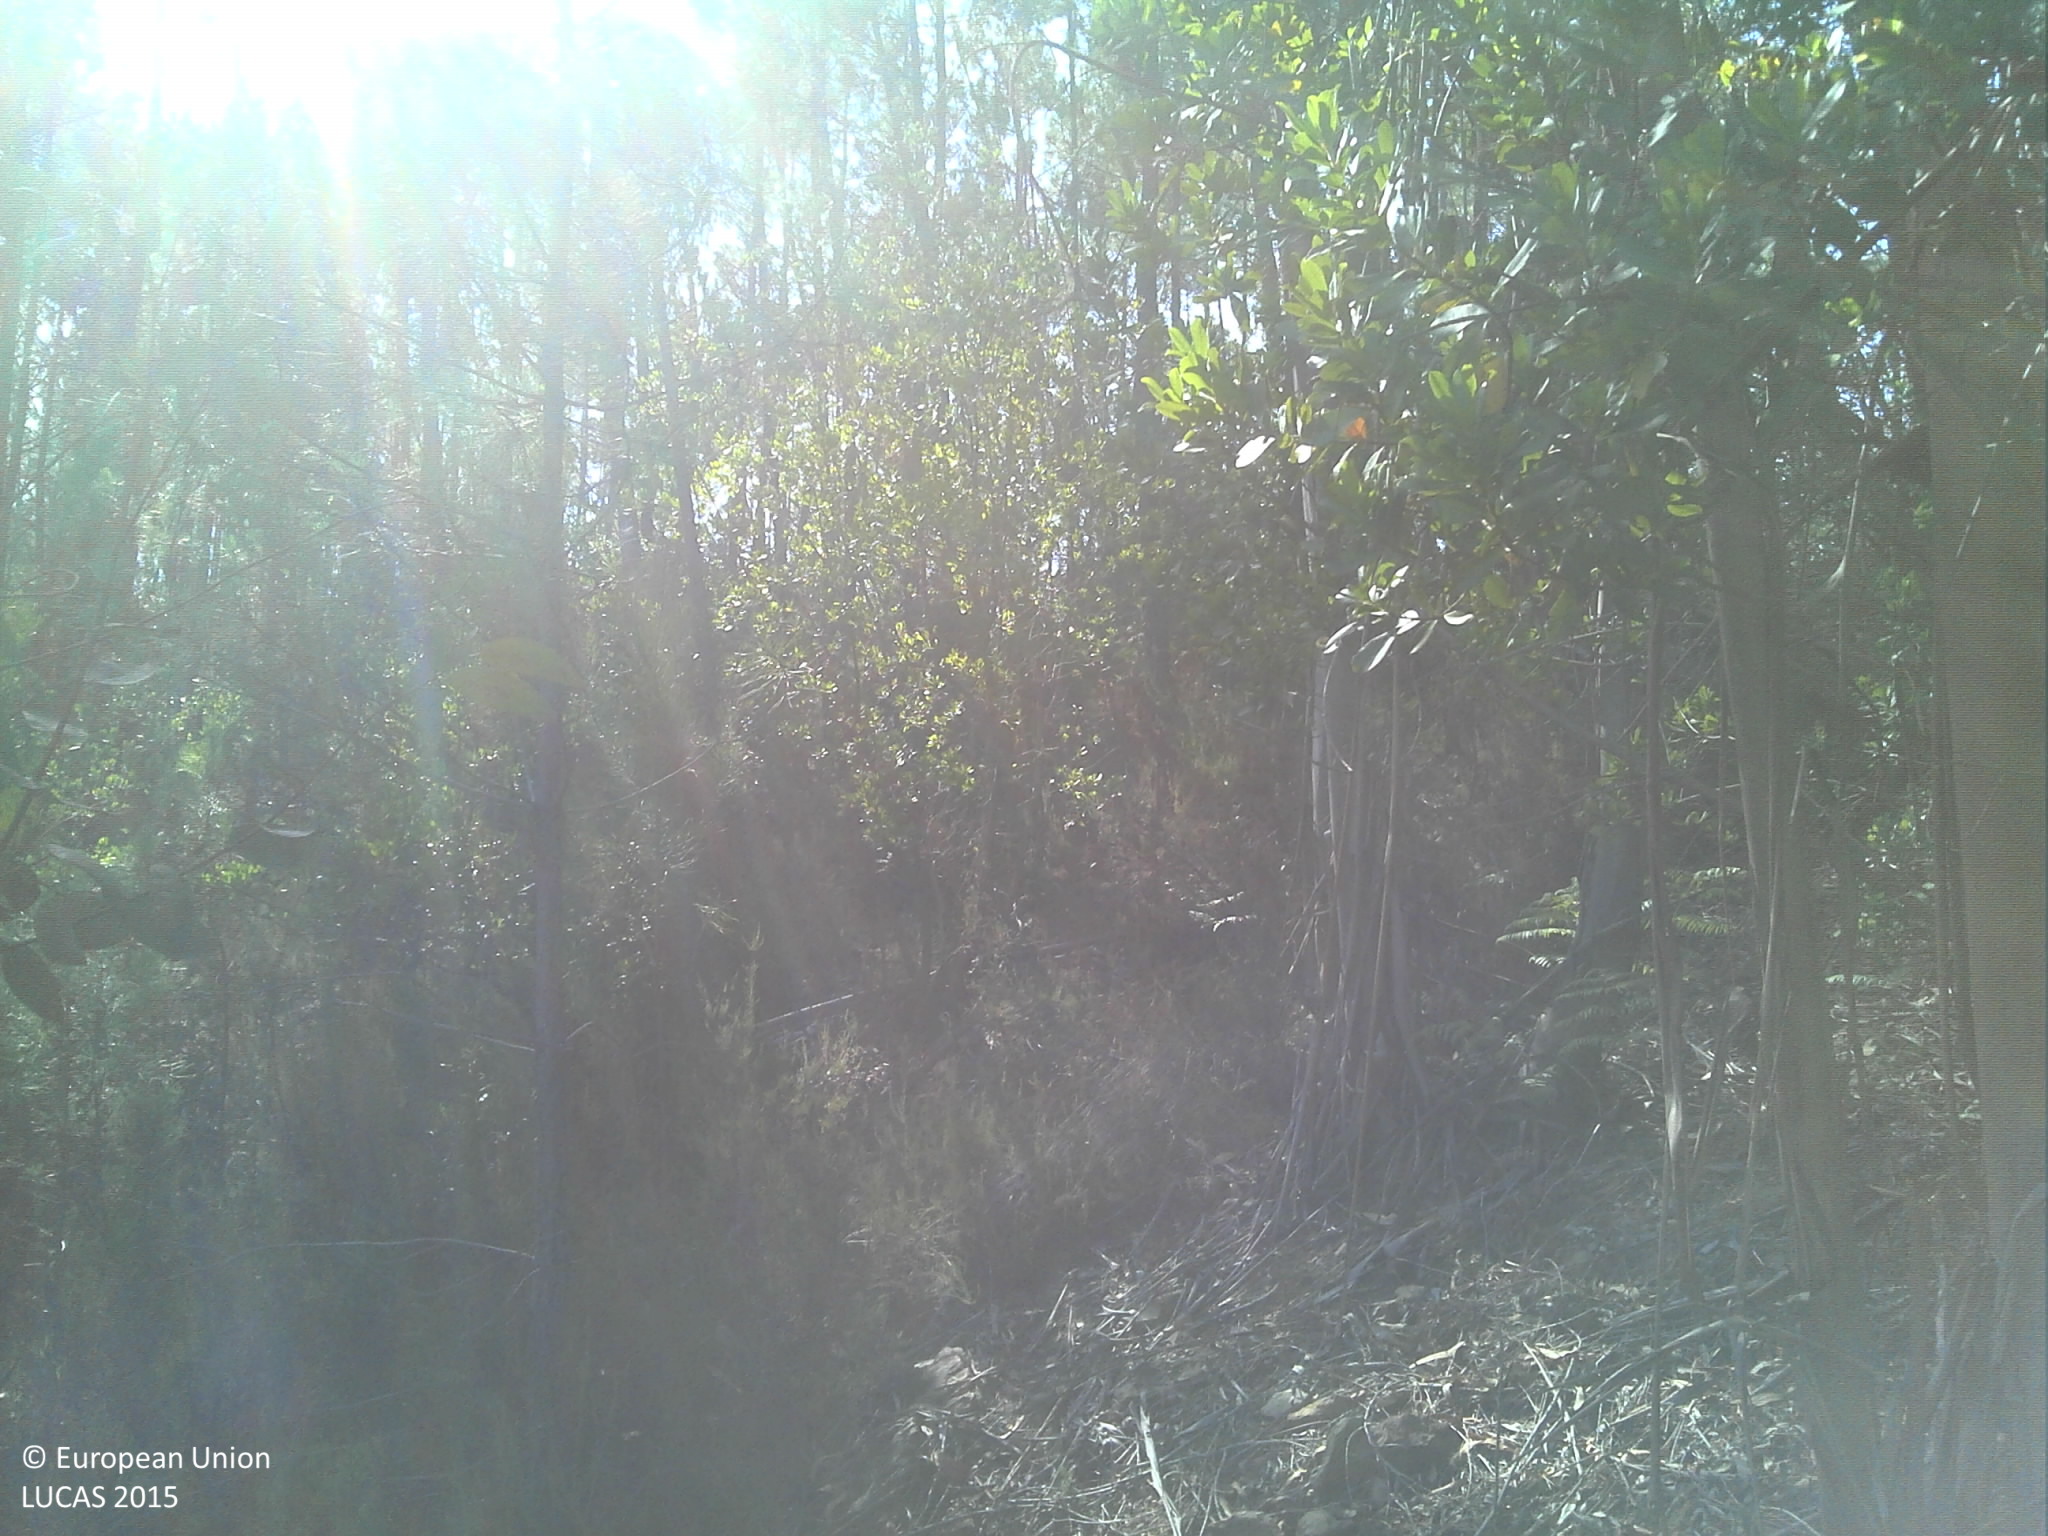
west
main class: Woodland
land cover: Pine dominated coniferous woodland
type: coniferous forest of the mediterranean region
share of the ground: 25 - 50 %
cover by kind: coniferous forest trees 50 %, shrubs 30 %, unconsolidated bare surface 20 %
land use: Forestry
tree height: > 5 m
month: July
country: PT
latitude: 39.9996
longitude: -7.8568
